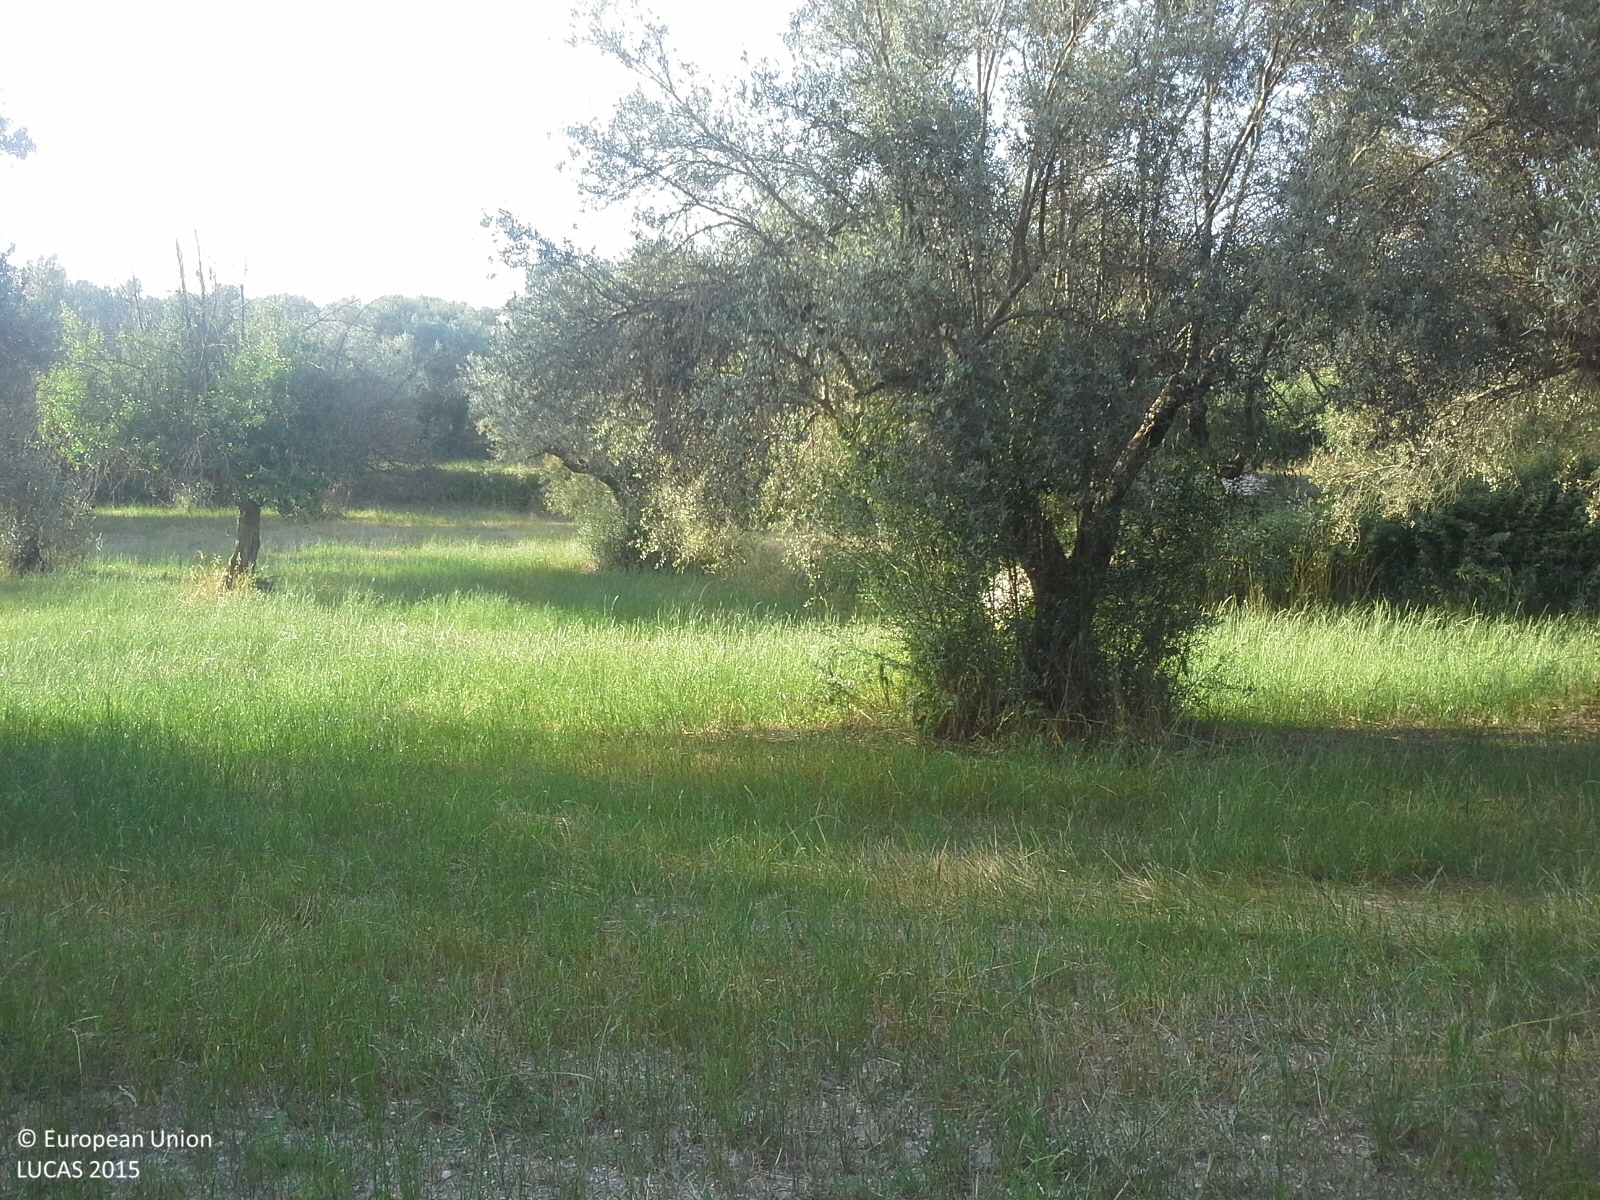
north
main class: Cropland
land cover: Olive groves
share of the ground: 50 - 75 %
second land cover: Mixed cereals for fodder
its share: > 75 %
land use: Agriculture (excluding fallow land and kitchen gardens)
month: June
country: IT
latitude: 36.9691
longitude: 14.8481
